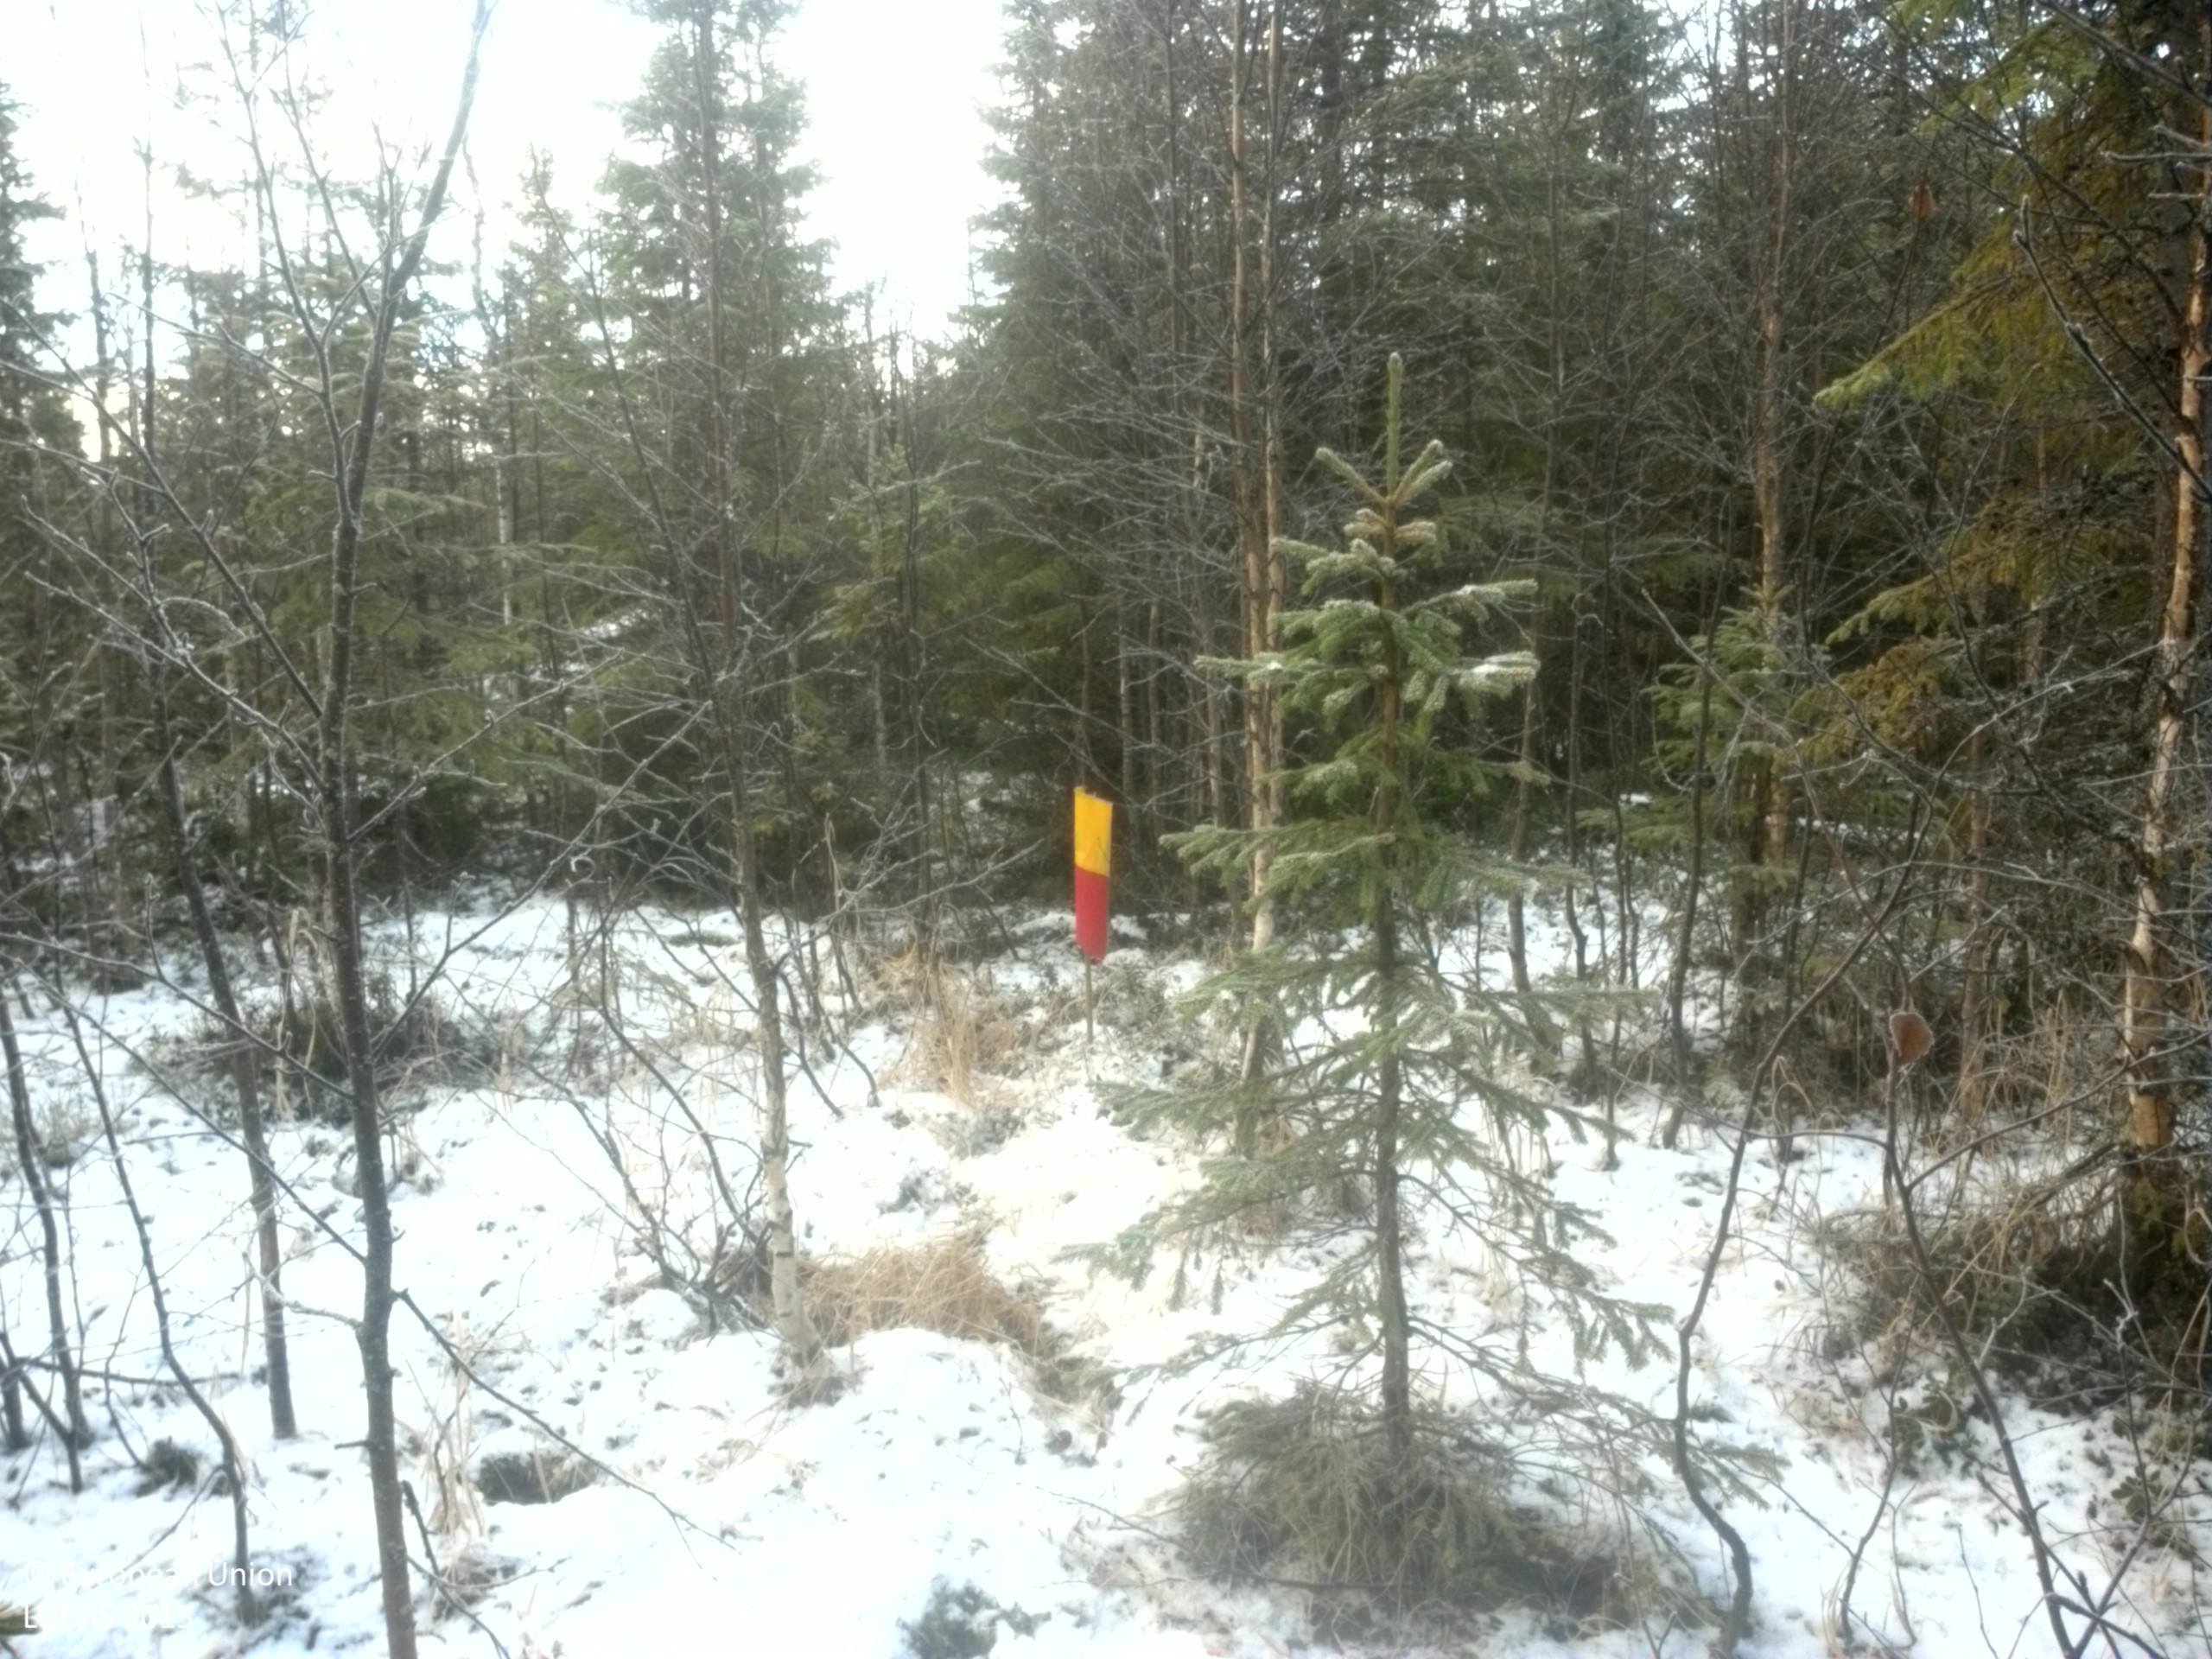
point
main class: Woodland
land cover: Spruce dominated mixed woodland
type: boreal forest
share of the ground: 50 - 75 %
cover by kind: coniferous forest trees 35 %, shrubs 25 %, broadleaved forest trees 15 %, lichens and mosses 15 %, herbaceous plants 10 %
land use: Forestry
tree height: < 5 m
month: November
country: SE
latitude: 63.9050
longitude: 15.9833
